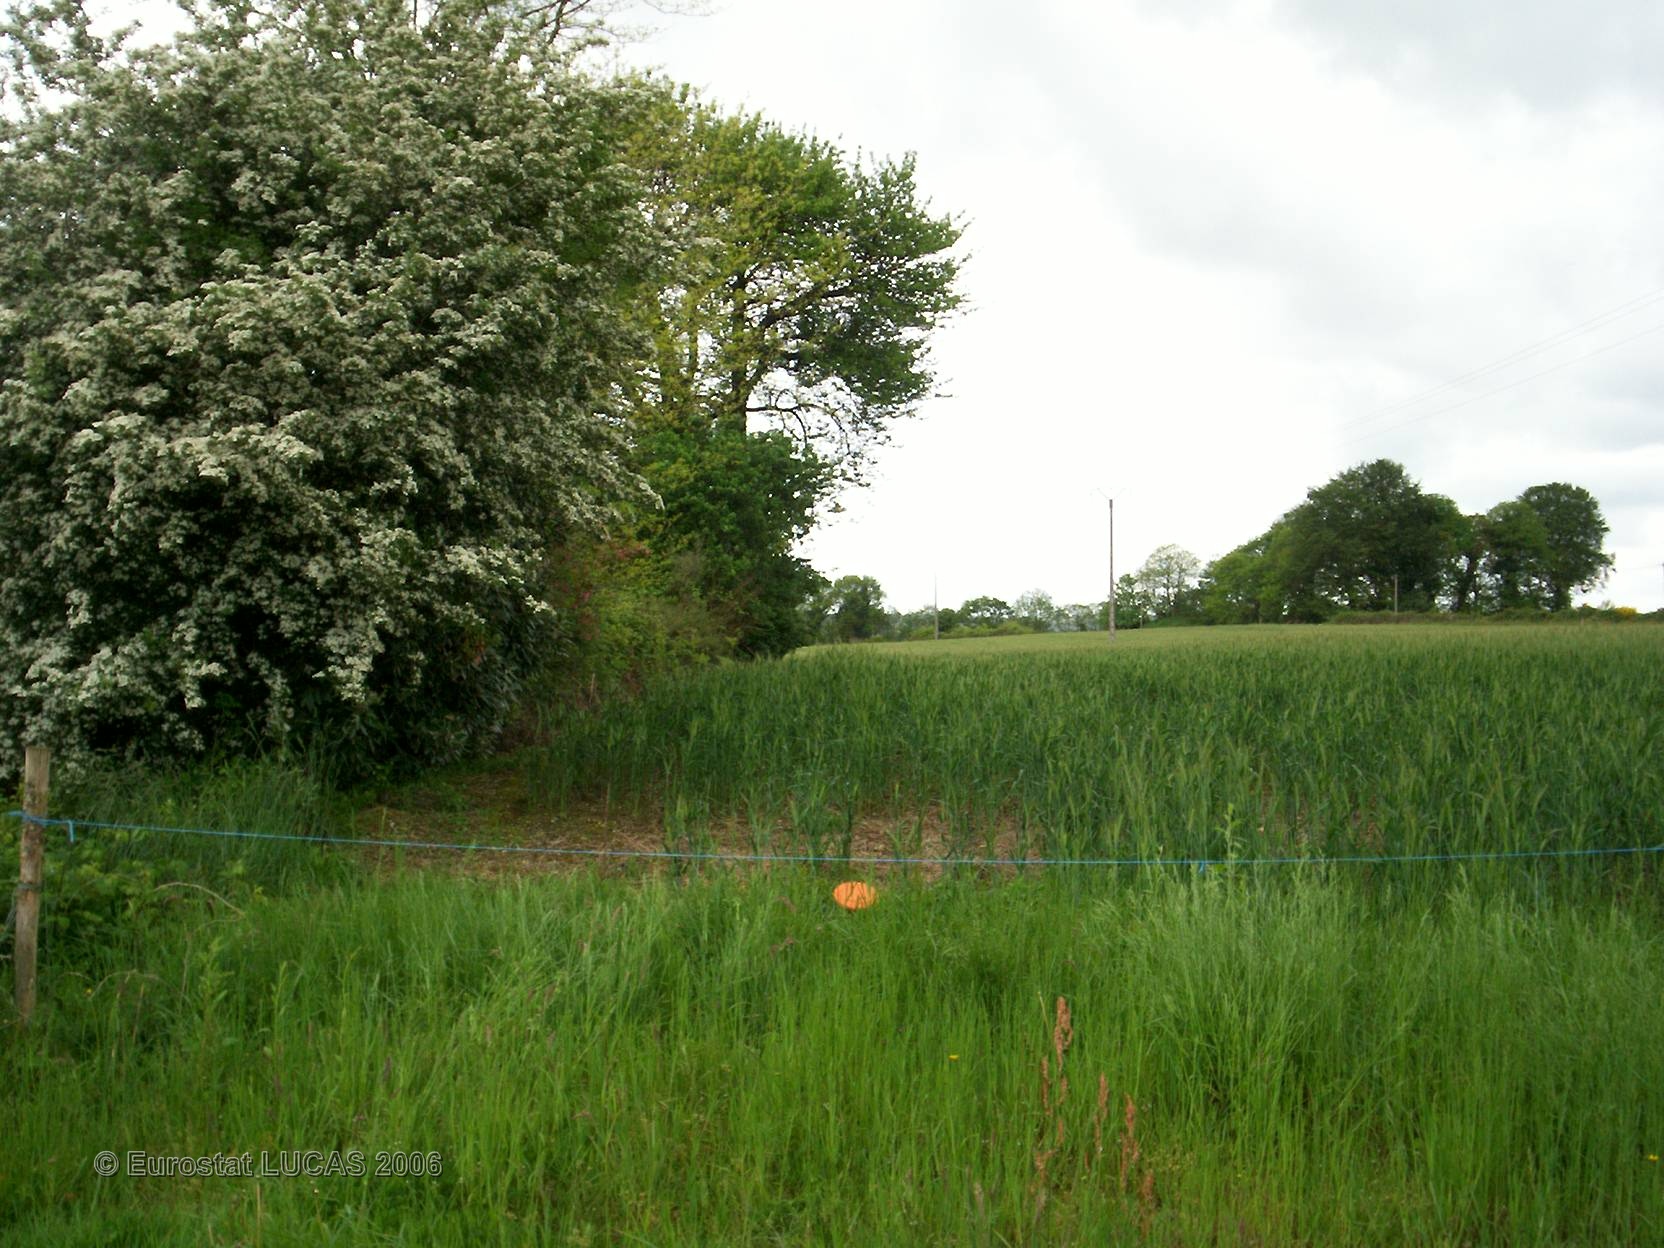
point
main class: Cropland
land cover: Common wheat
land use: Agriculture (excluding fallow land and kitchen gardens)
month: May
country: FR
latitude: 48.0733
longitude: -3.5669
